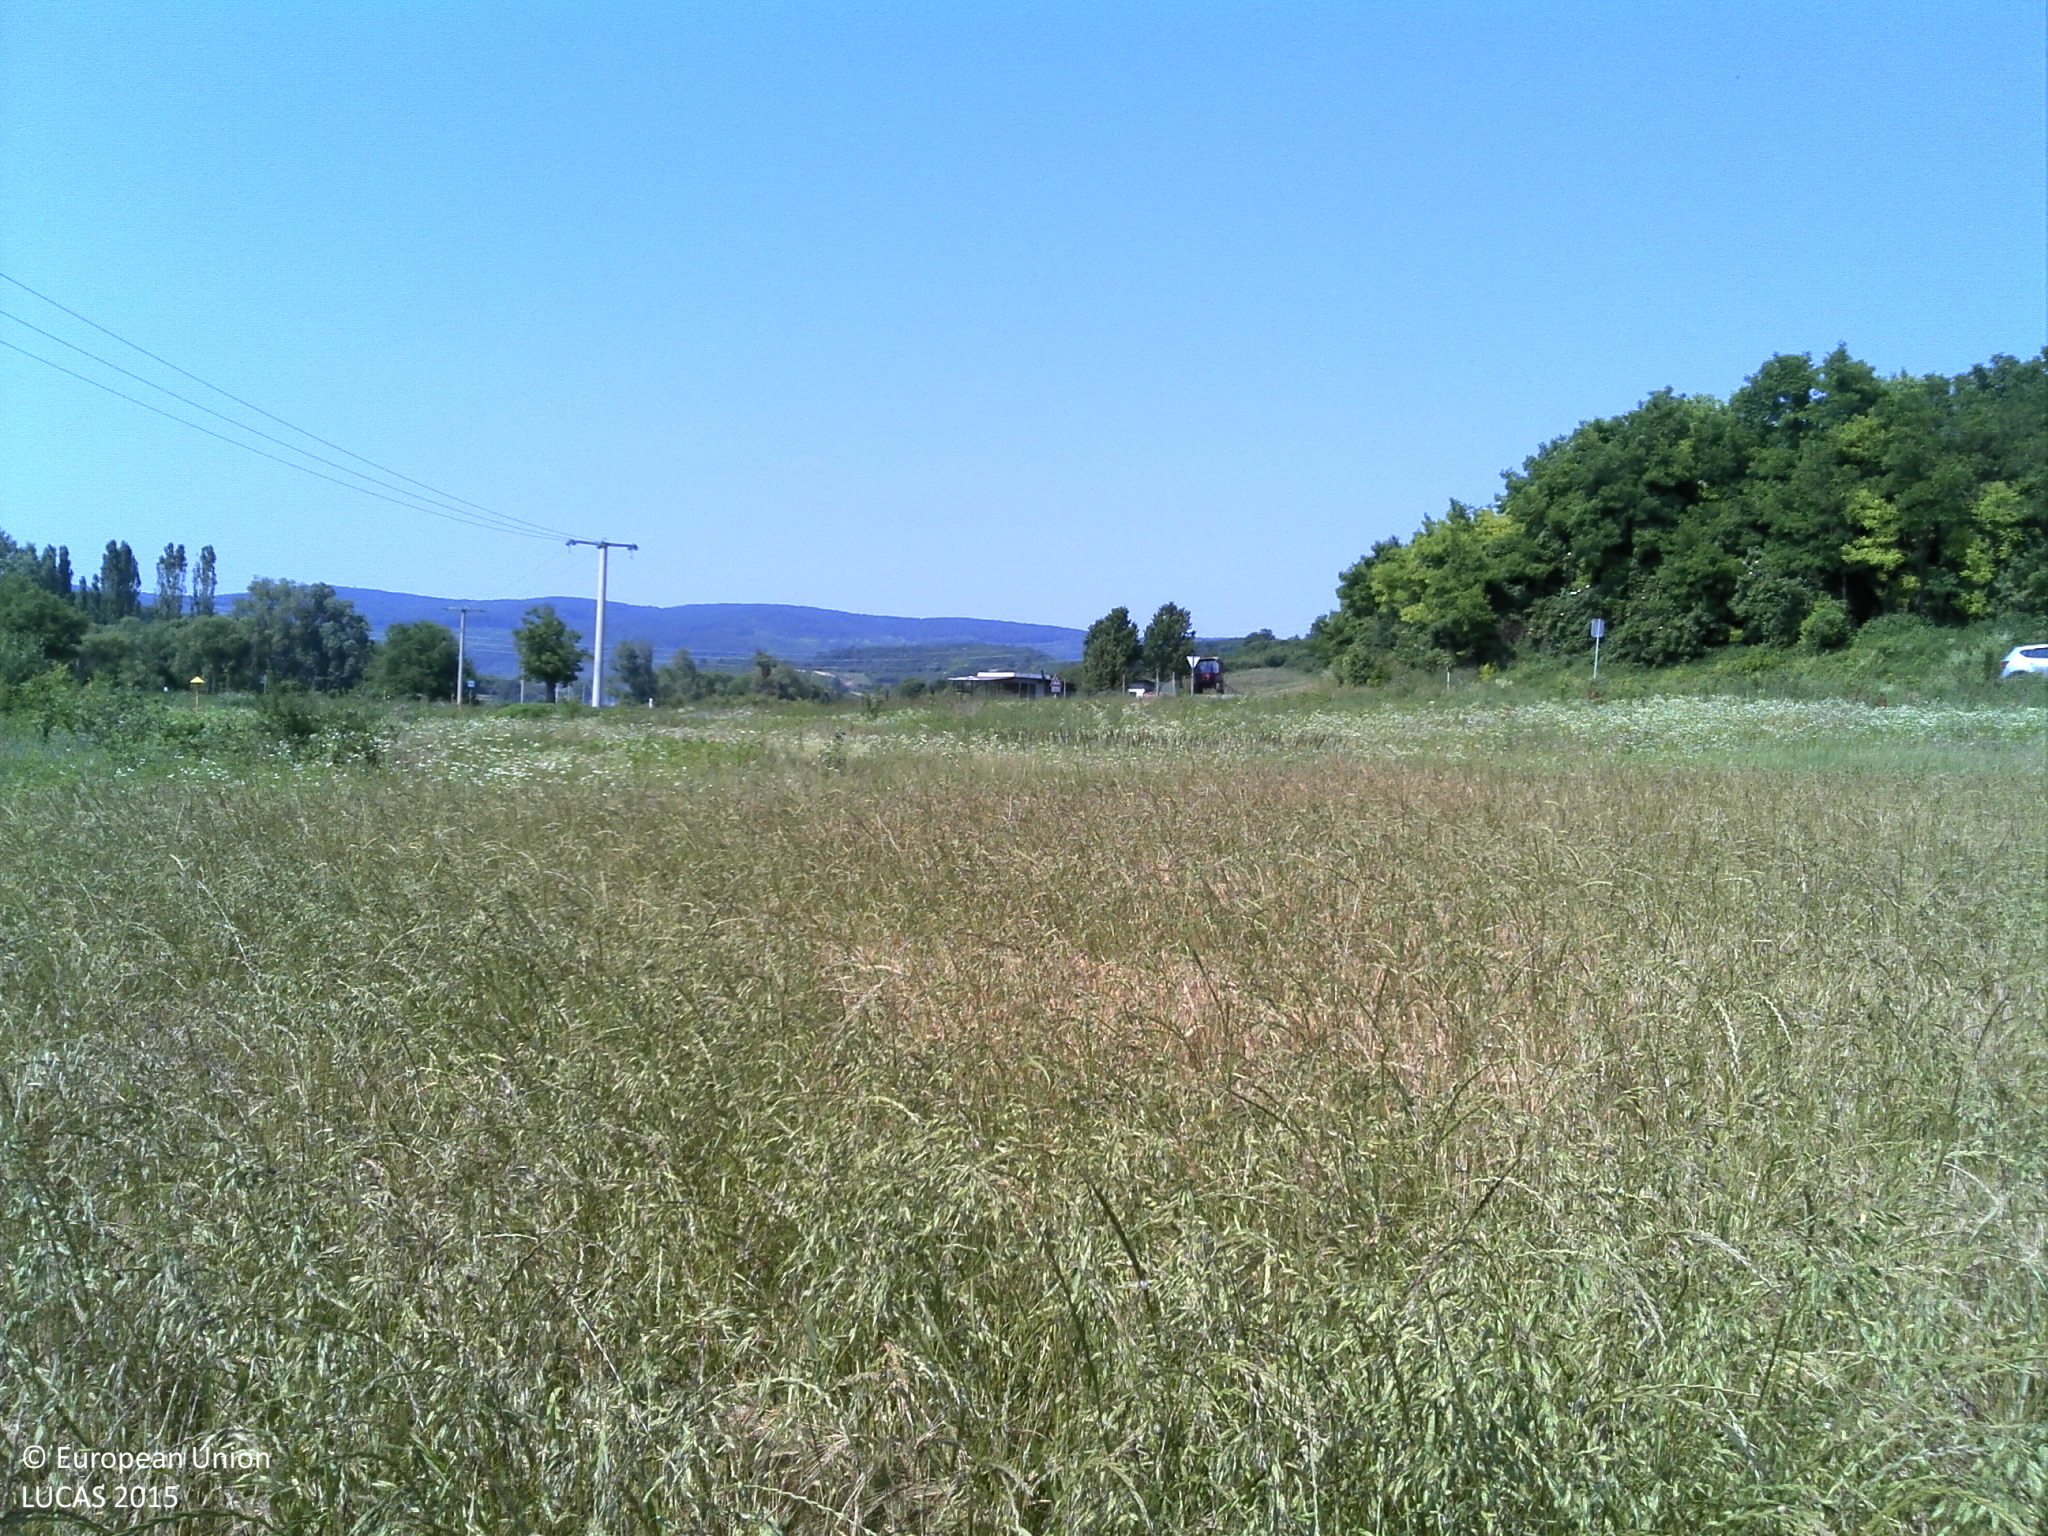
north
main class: Cropland
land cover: Mixed cereals for fodder
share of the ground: > 75 %
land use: Agriculture (excluding fallow land and kitchen gardens)
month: June
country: HR
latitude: 45.2375
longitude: 17.9897
